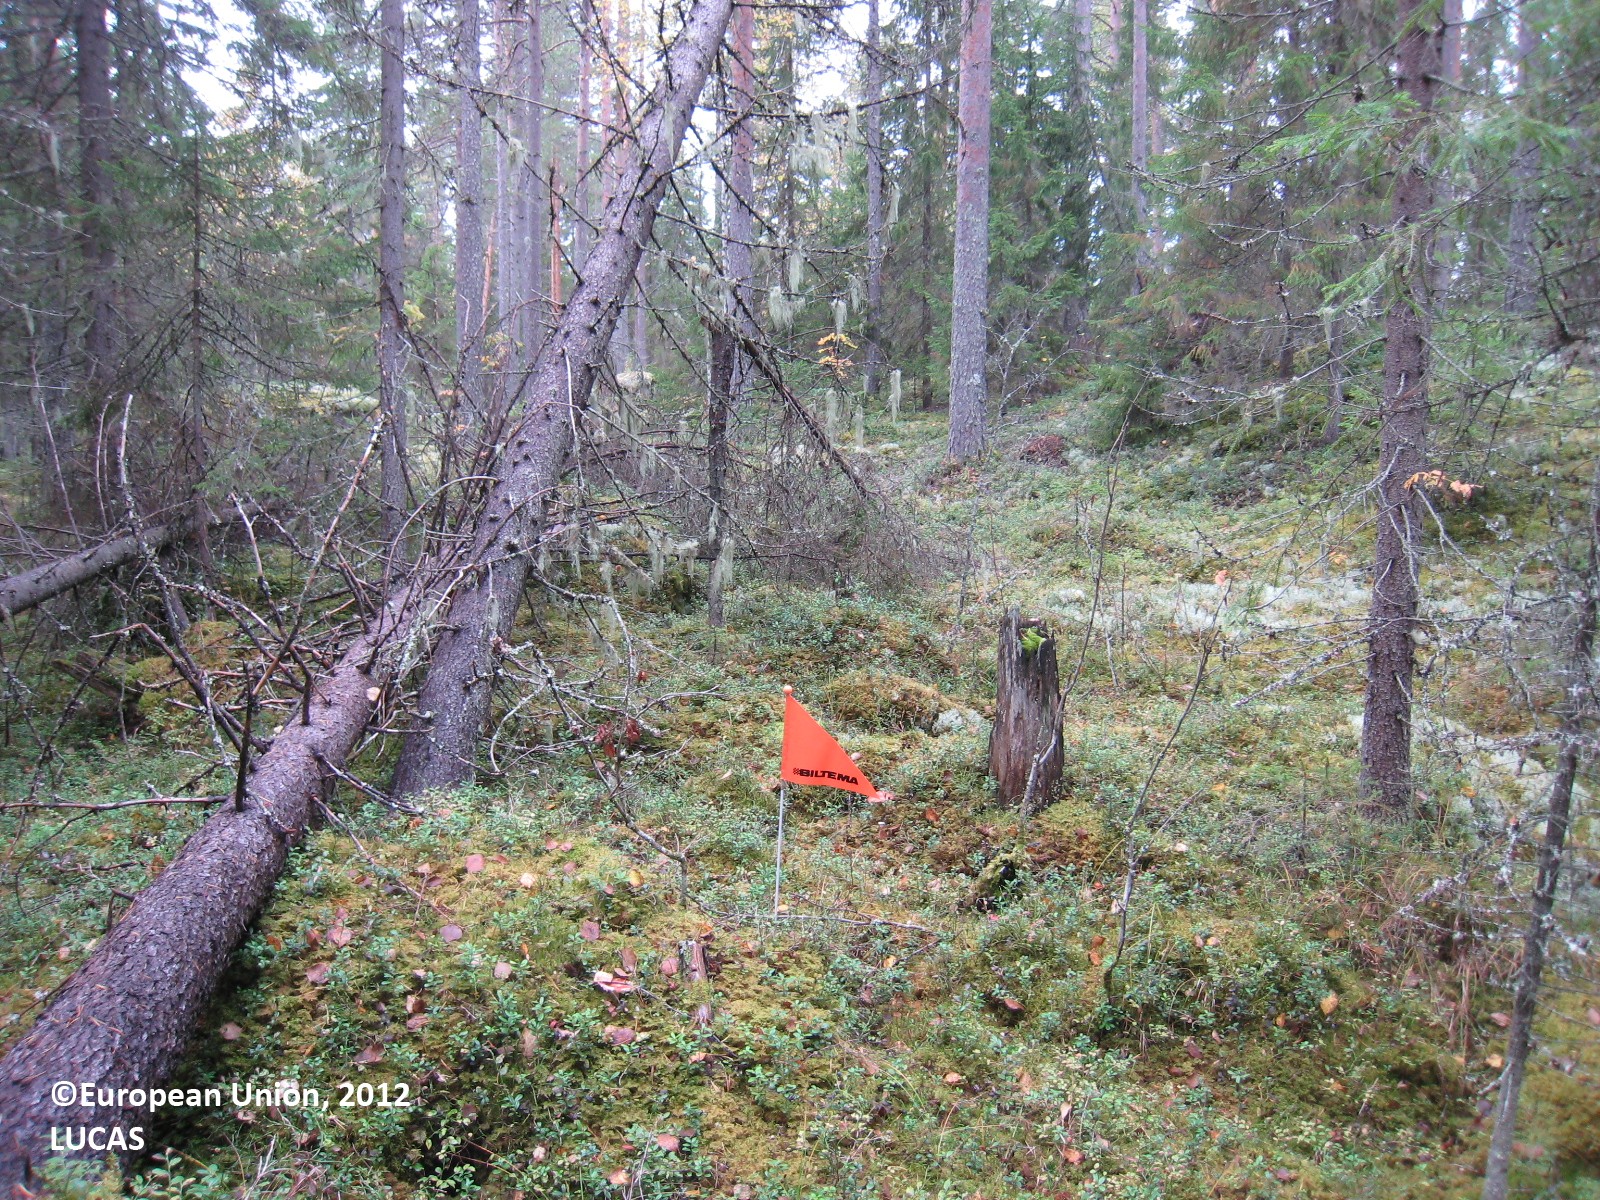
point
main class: Woodland
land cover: Other coniferous woodland
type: boreal forest
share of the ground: > 75 %
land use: Forestry
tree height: > 5 m
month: September
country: FI
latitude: 62.7258
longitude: 26.1859
